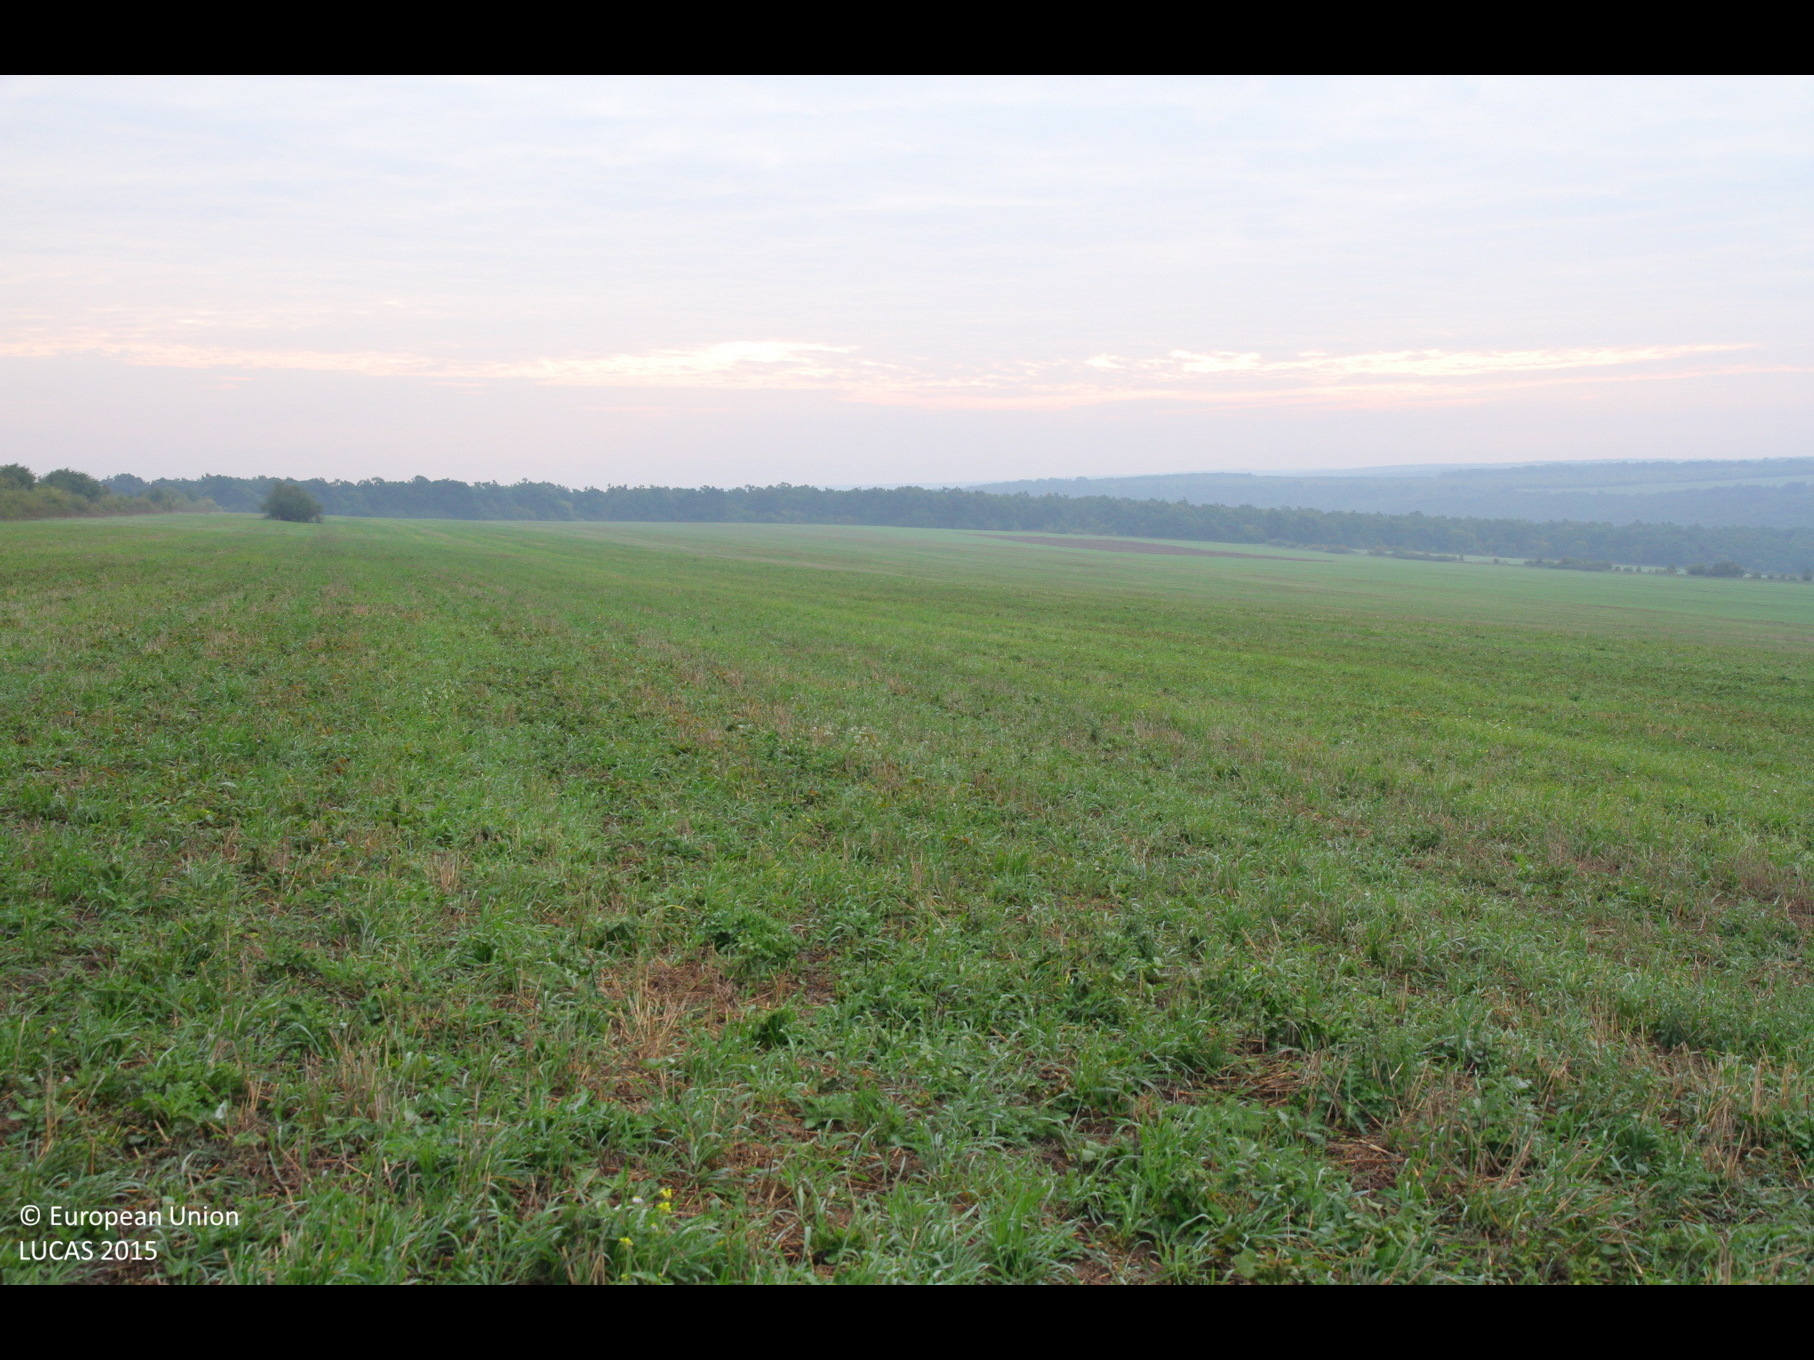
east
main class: Cropland
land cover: Common wheat
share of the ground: < 10 %
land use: Agriculture (excluding fallow land and kitchen gardens)
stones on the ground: < 10 %
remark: Harvested field
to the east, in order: Common wheat
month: October
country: BG
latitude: 43.4881
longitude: 26.9954
